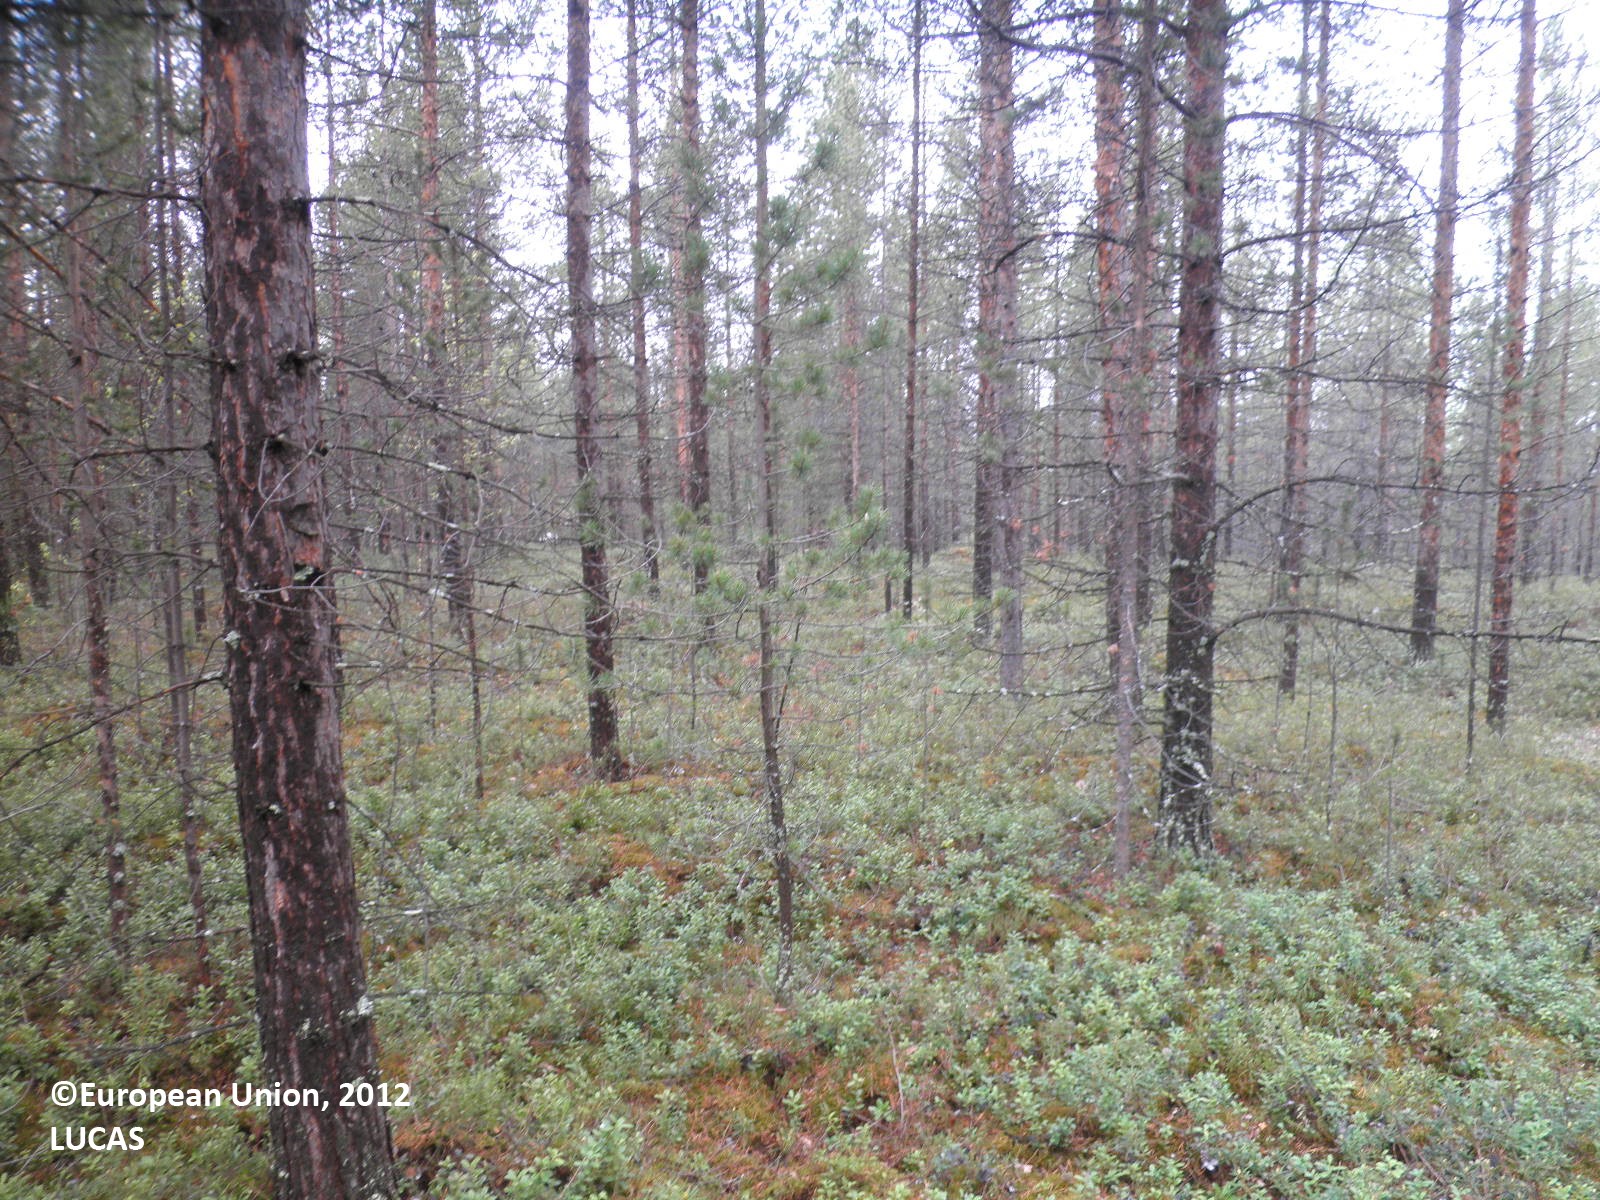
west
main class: Woodland
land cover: Pine dominated coniferous woodland
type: boreal forest
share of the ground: 25 - 50 %
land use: Forestry
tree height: > 5 m
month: June
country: FI
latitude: 68.7070
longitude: 27.7763
